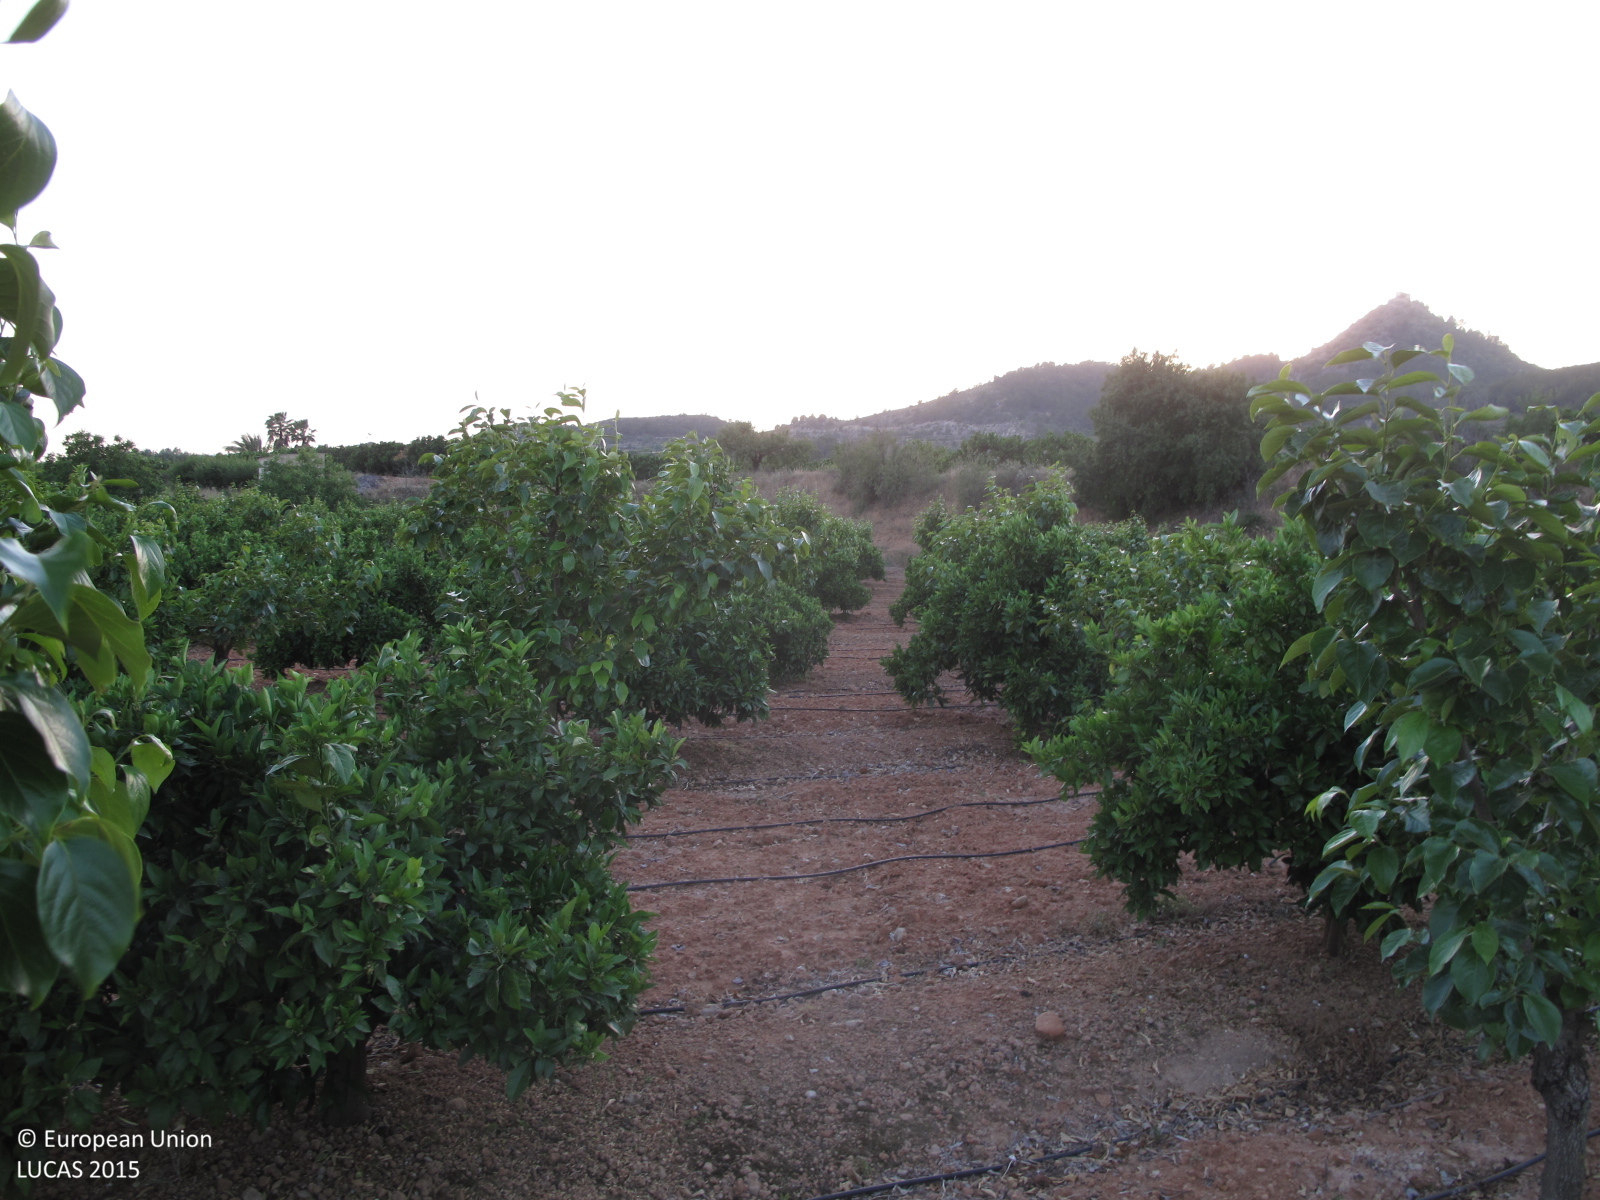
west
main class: Cropland
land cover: Oranges
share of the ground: 25 - 50 %
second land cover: Other fruit trees and berries
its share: 25 - 50 %
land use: Agriculture (excluding fallow land and kitchen gardens)
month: May
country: ES
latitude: 39.0257
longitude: -0.5159
